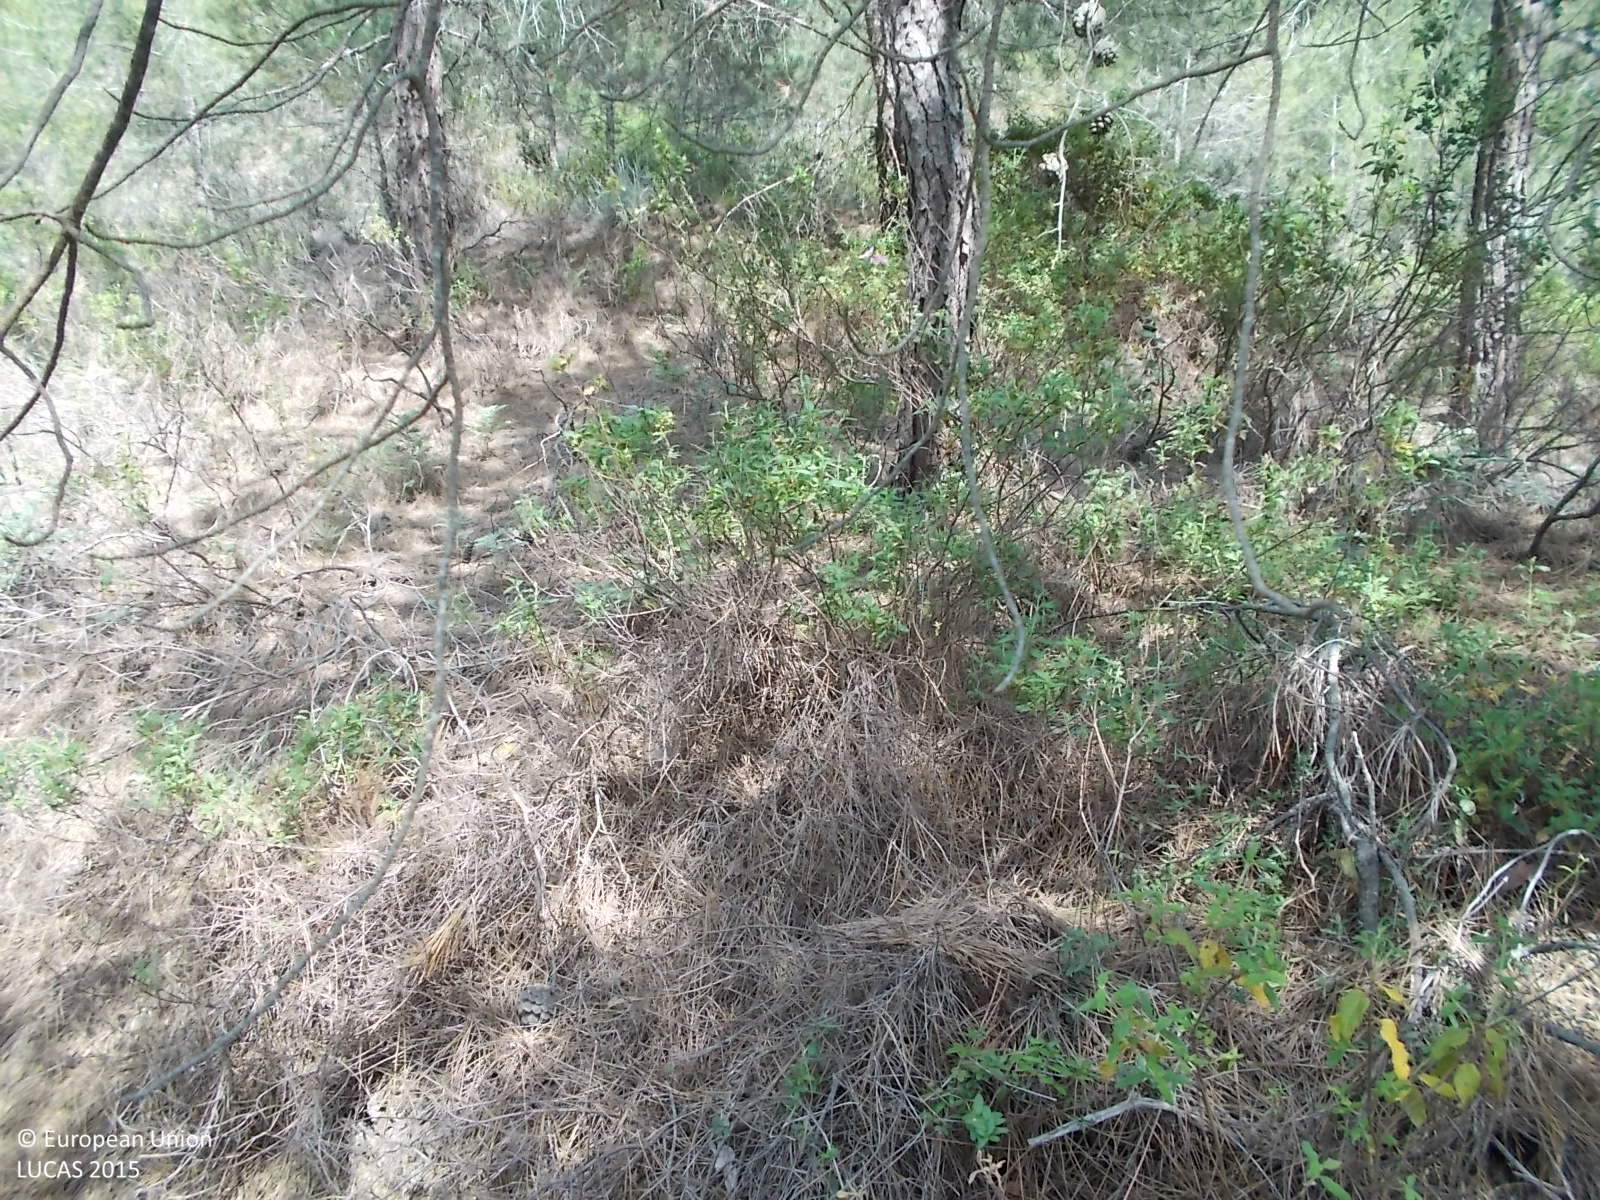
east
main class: Woodland
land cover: Pine dominated coniferous woodland
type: coniferous forest of the mediterranean region
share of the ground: > 75 %
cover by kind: coniferous forest trees 90 %, shrubs 5 %, unconsolidated bare surface 5 %
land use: Semi-natural and natural areas not in use
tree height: > 5 m
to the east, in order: Pine dominated coniferous woodland; Tracks; Pine dominated coniferous woodland; Tracks
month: June
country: CY
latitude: 35.0276
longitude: 32.5954
